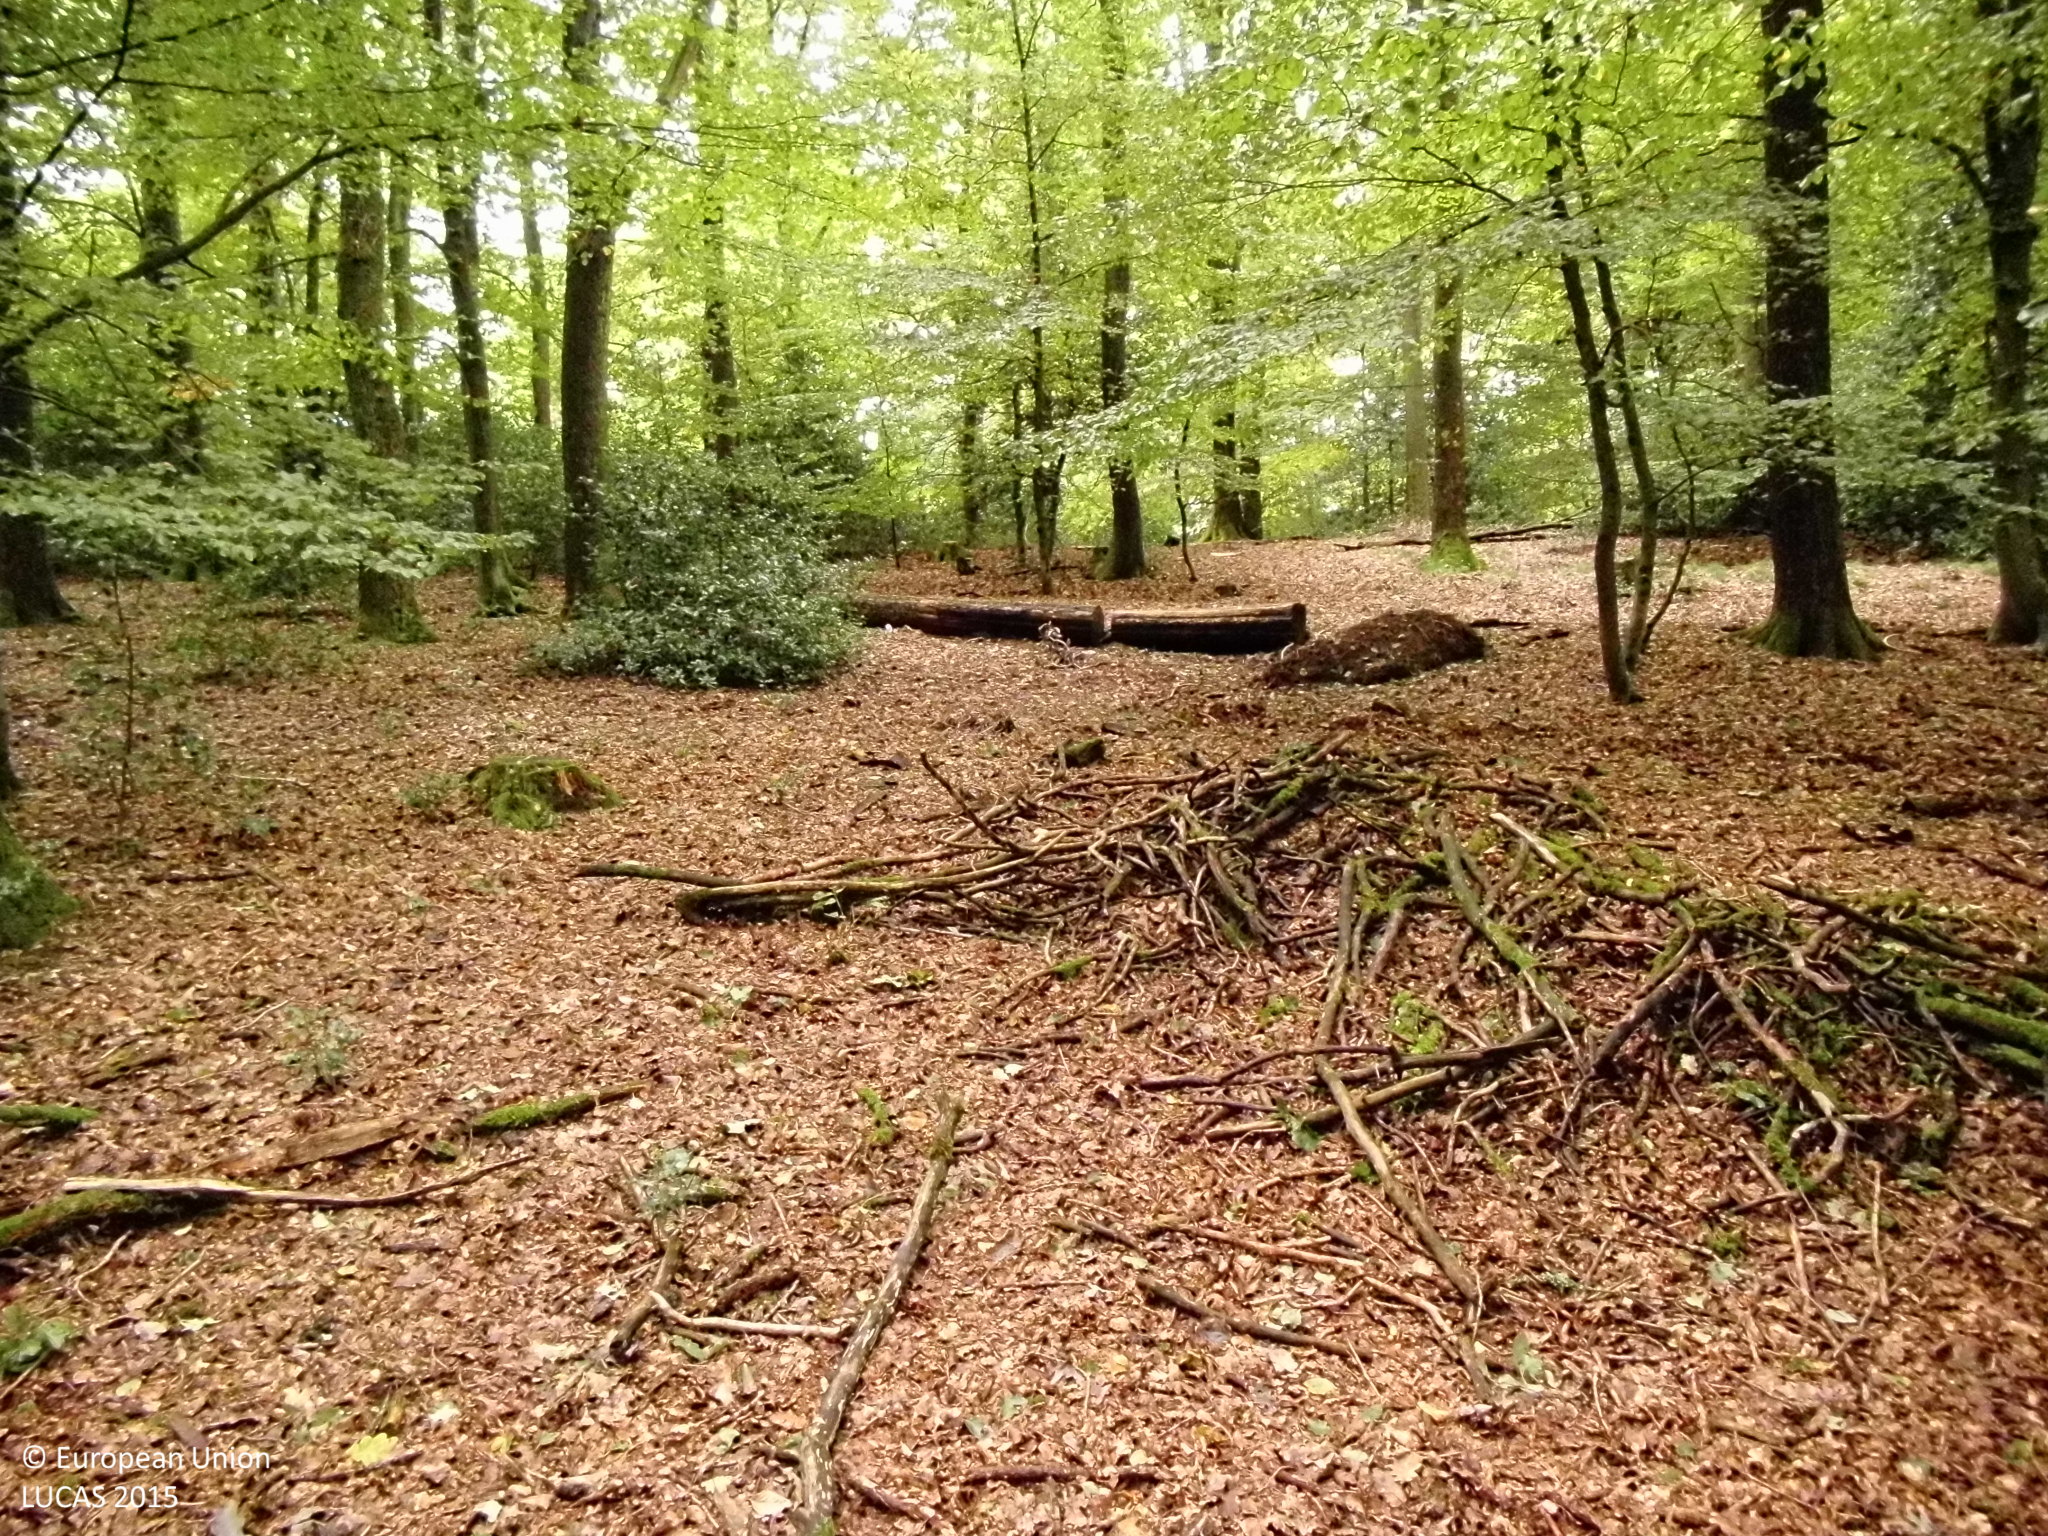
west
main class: Woodland
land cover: Broadleaved woodland
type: mesophytic deciduous forest
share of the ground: > 75 %
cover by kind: broadleaved forest trees 100 %
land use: Forestry
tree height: > 5 m
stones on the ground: < 10 %
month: September
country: DE
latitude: 51.0923
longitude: 7.5016
